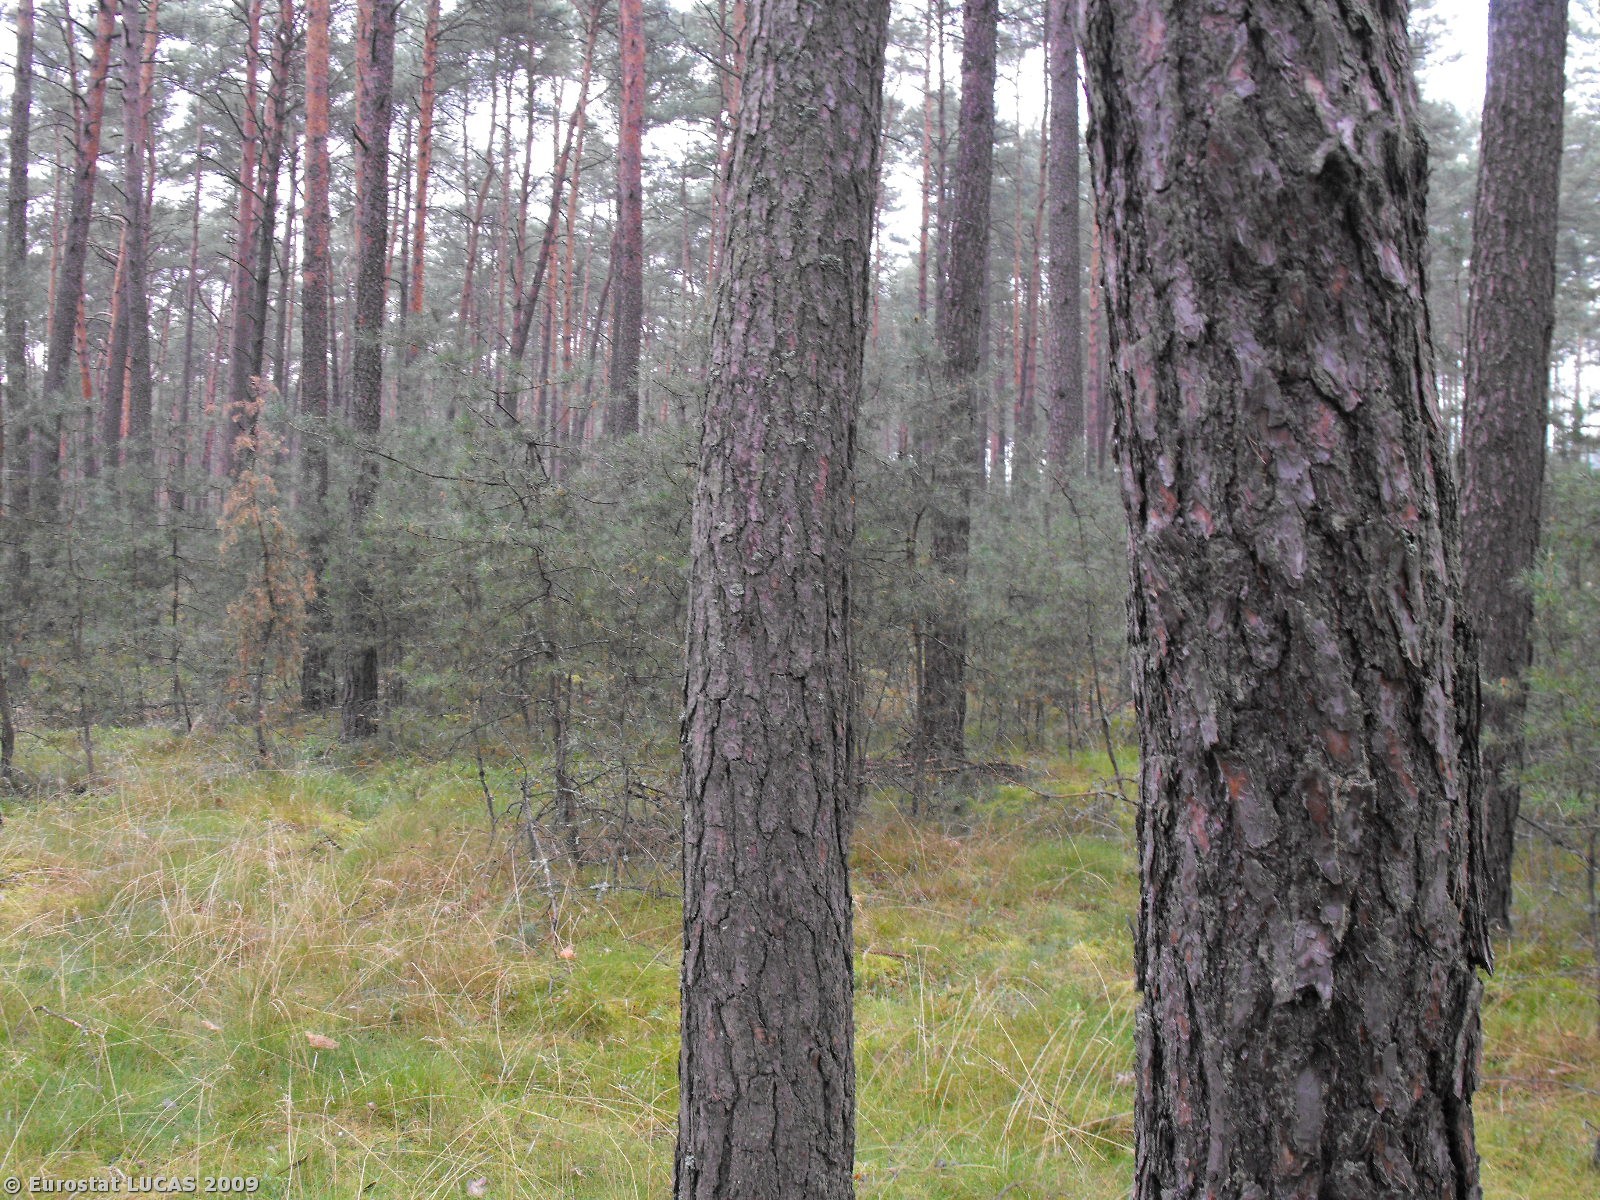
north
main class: Woodland
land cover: Coniferous woodland
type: hemiboreal forest and nemoral coniferous forest and mixed broadleaved-coniferous forest
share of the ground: > 75 %
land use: Forestry
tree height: > 5 m
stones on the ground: < 10 %
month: September
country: PL
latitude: 52.9430
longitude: 16.4206
